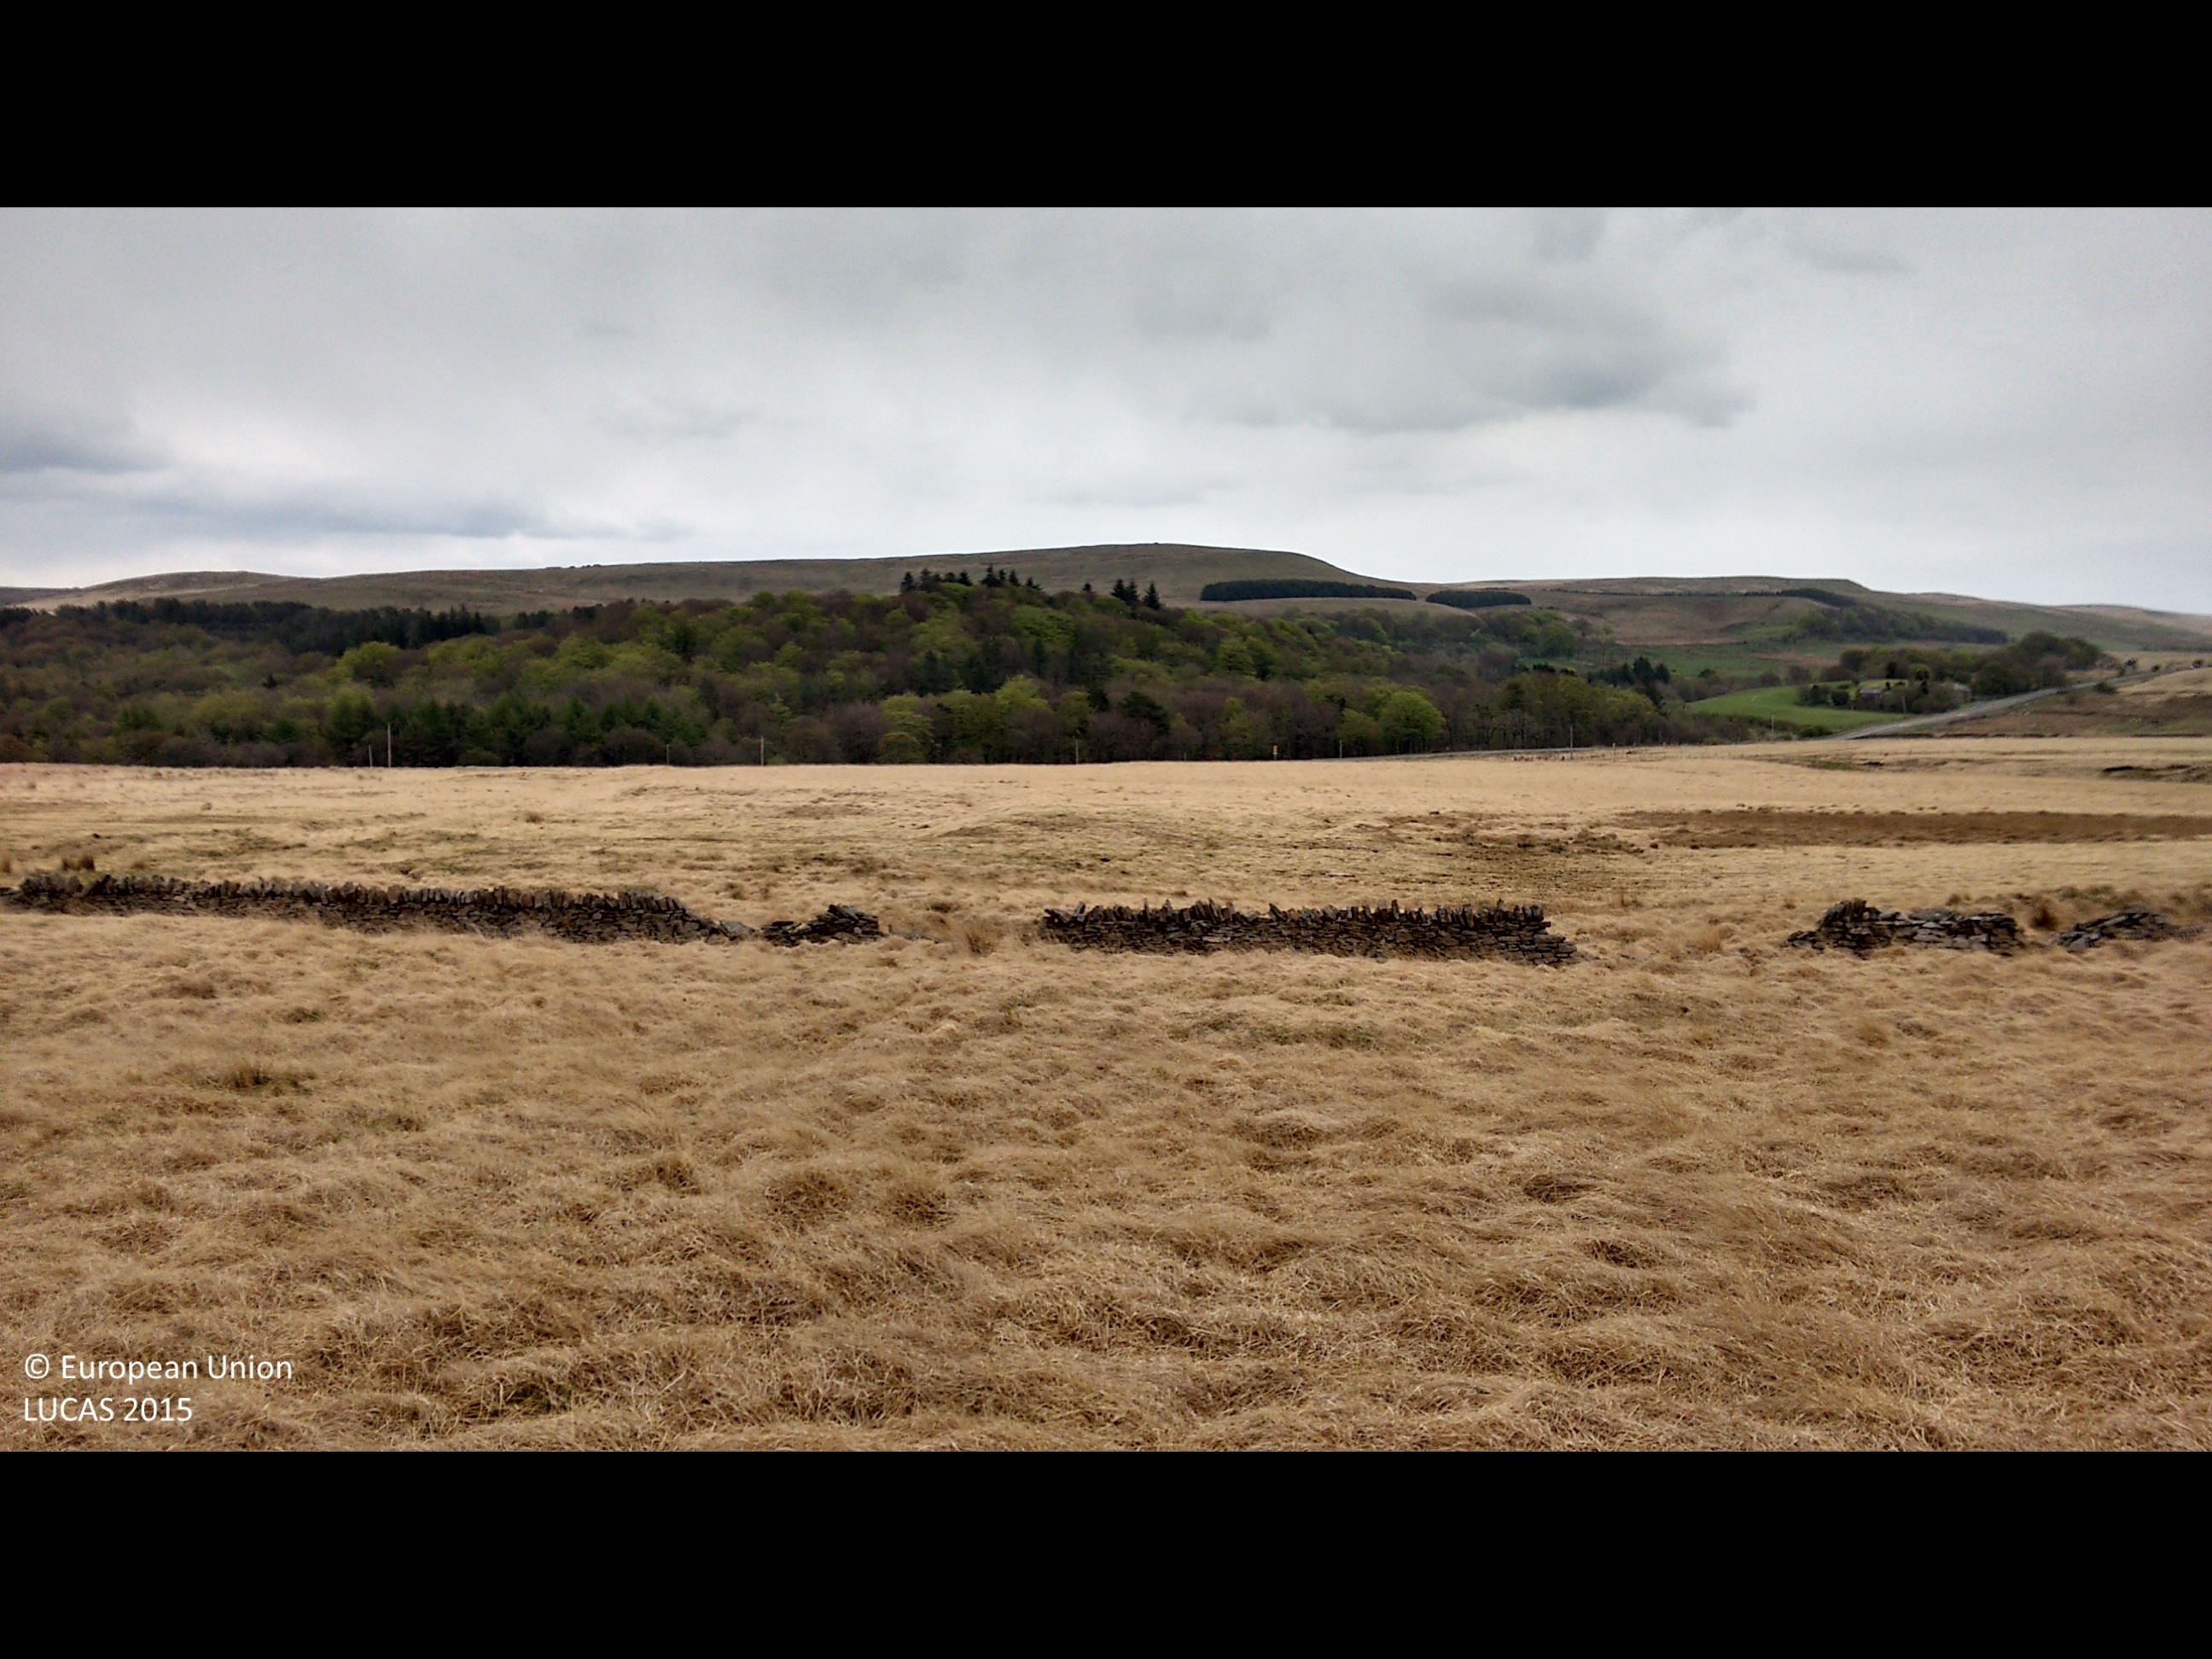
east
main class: Grassland
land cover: Grassland without tree/shrub cover
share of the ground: > 75 %
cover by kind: herbaceous plants 100 %
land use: Agriculture (excluding fallow land and kitchen gardens)
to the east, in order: Grassland without tree/shrub cover; Dry stone walls; Grassland without tree/shrub cover
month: May
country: GB
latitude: 53.6769
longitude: -2.5247
